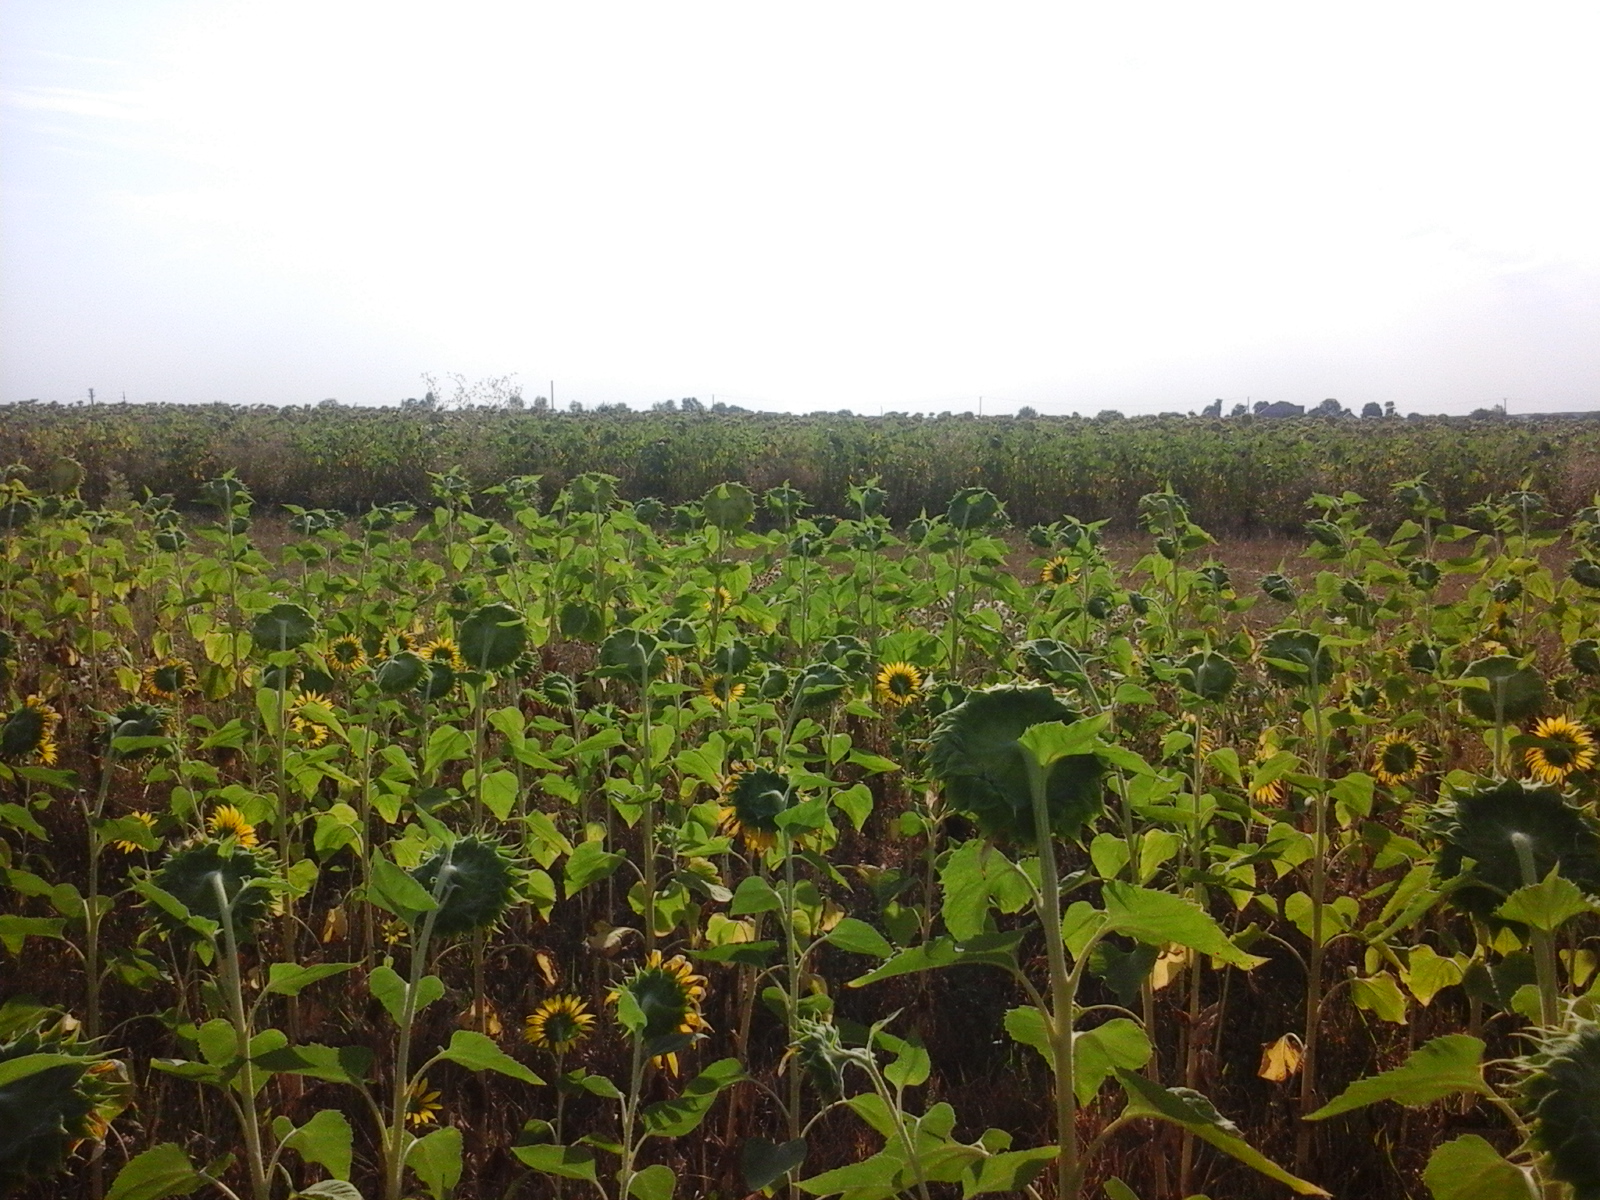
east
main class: Cropland
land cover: Sunflower
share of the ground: > 75 %
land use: Agriculture (excluding fallow land and kitchen gardens)
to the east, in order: Sunflower; Common wheat; Sunflower; Common wheat; Grass margins; Tracks; Grass margins; Common wheat
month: August
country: RO
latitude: 44.1681
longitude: 23.6981
